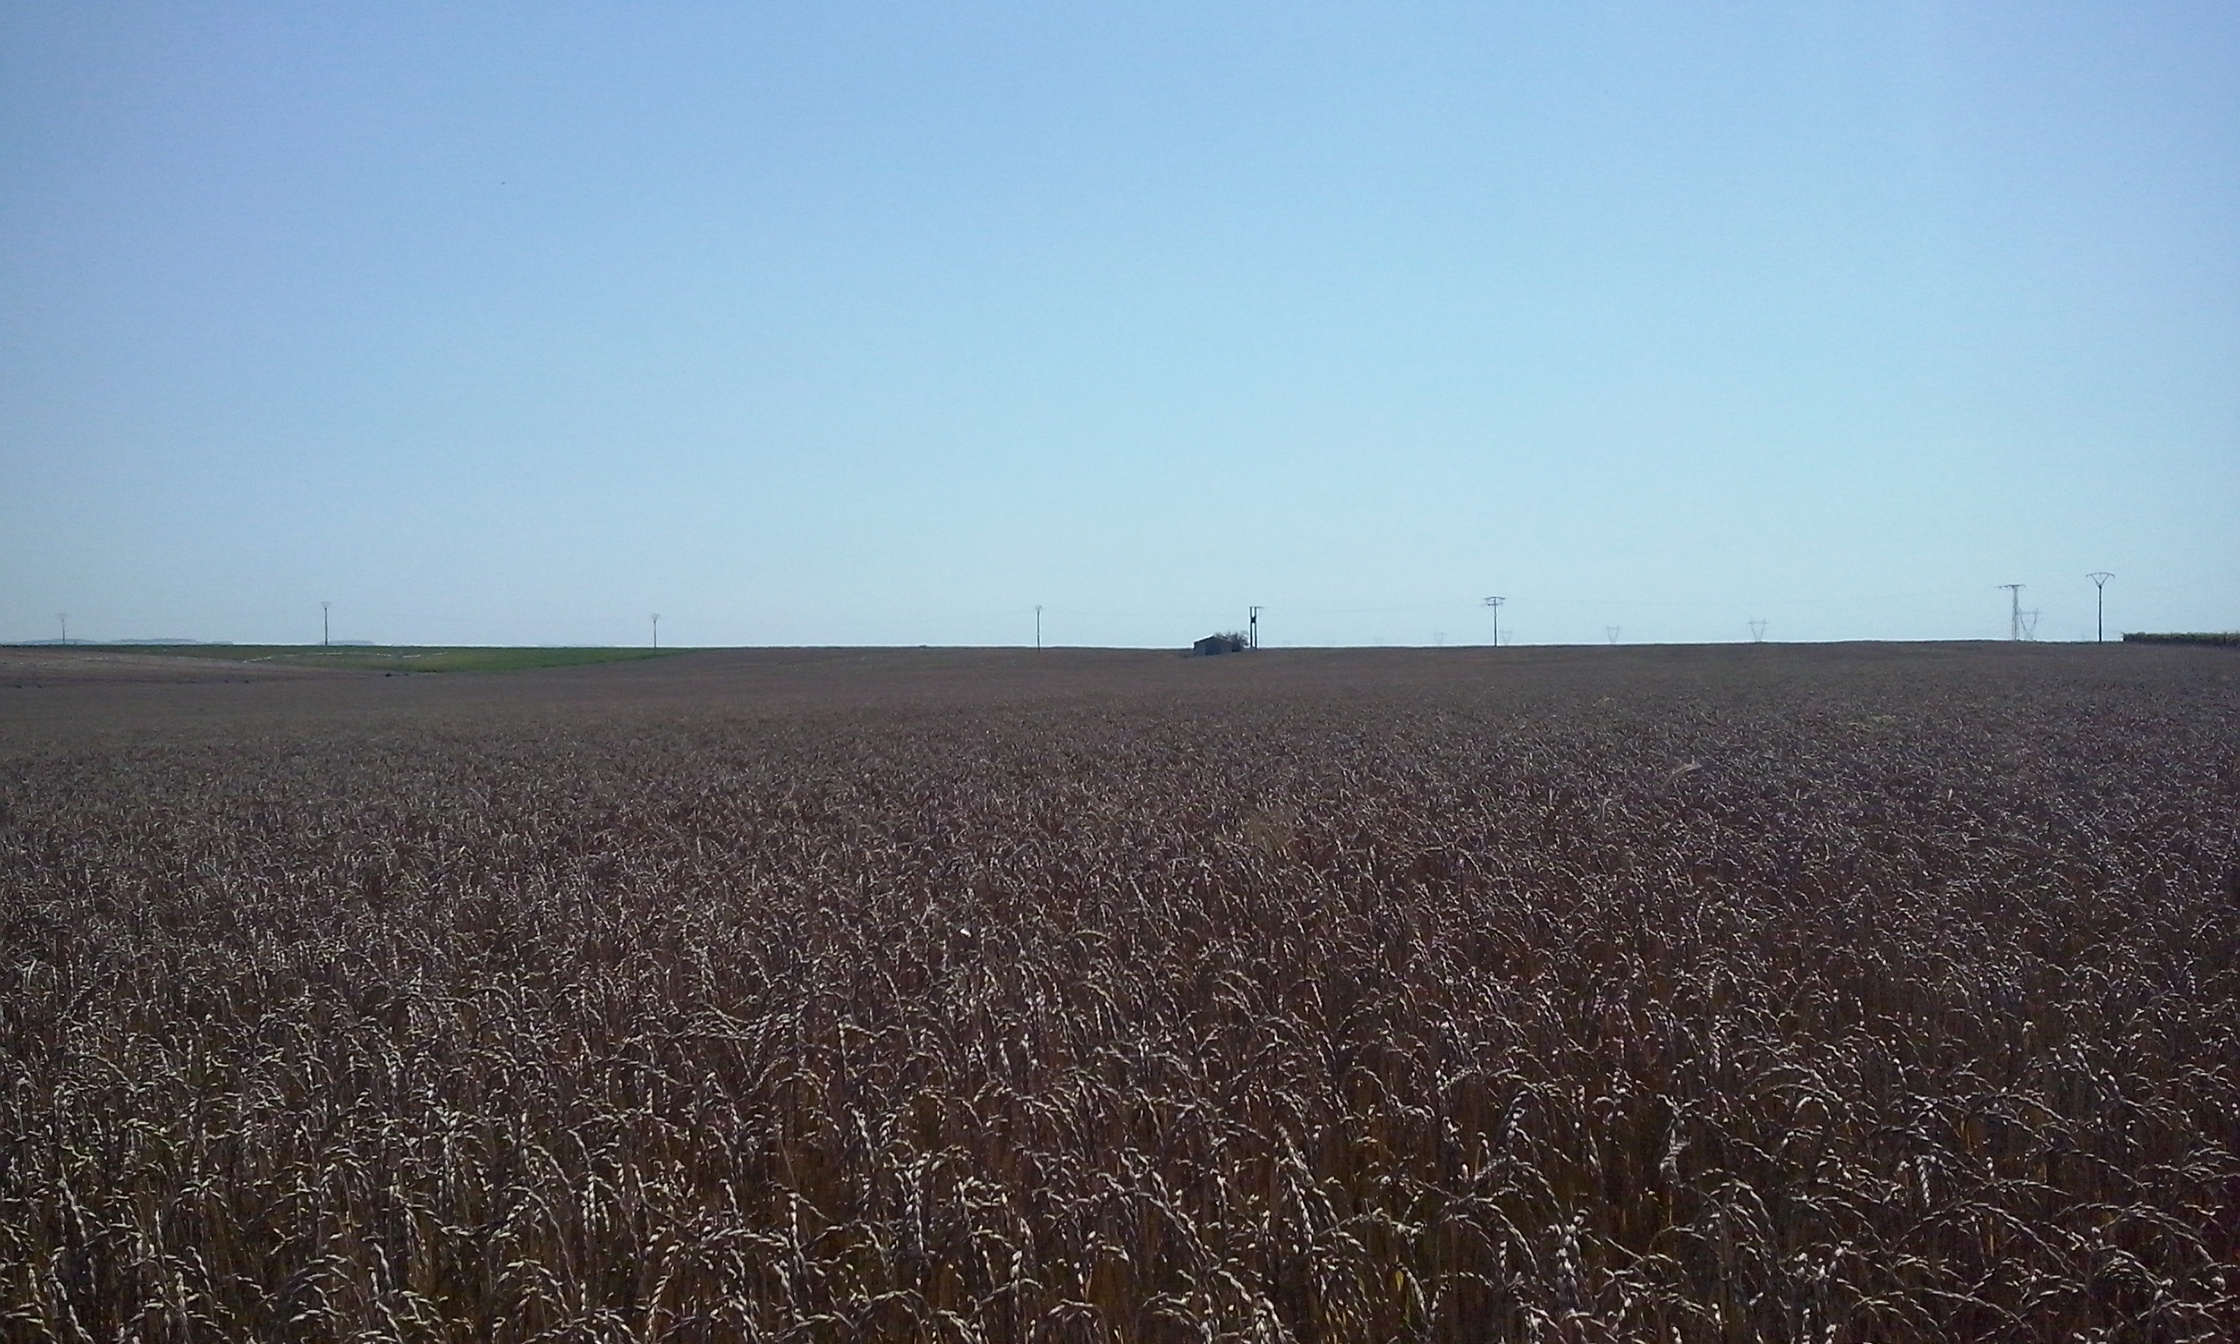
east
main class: Cropland
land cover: Other cereals
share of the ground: > 75 %
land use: Agriculture (excluding fallow land and kitchen gardens)
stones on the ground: 25 - 50 %
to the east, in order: Other cereals
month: June
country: ES
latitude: 41.4878
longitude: -5.1540
